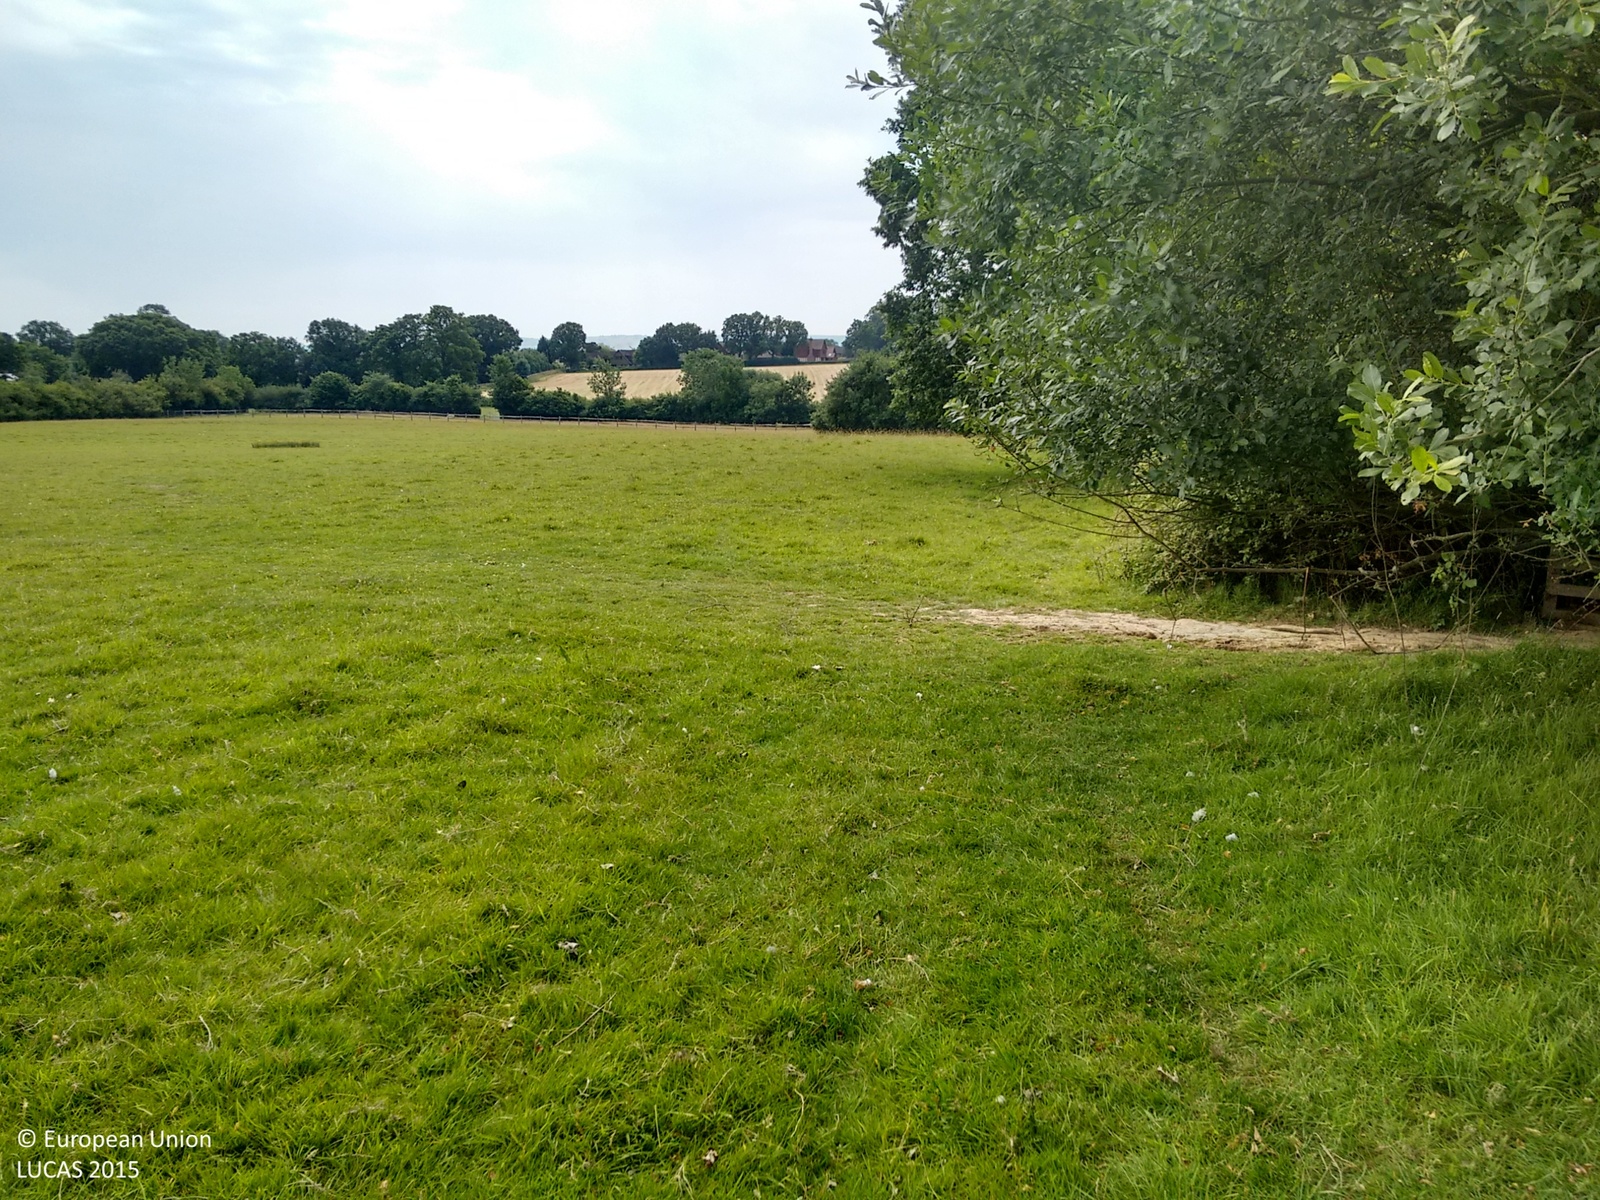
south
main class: Grassland
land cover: Grassland without tree/shrub cover
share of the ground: > 75 %
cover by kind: herbaceous plants 100 %
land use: Agriculture (excluding fallow land and kitchen gardens)
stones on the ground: < 10 %
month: July
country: GB
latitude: 50.9694
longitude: -0.0730
